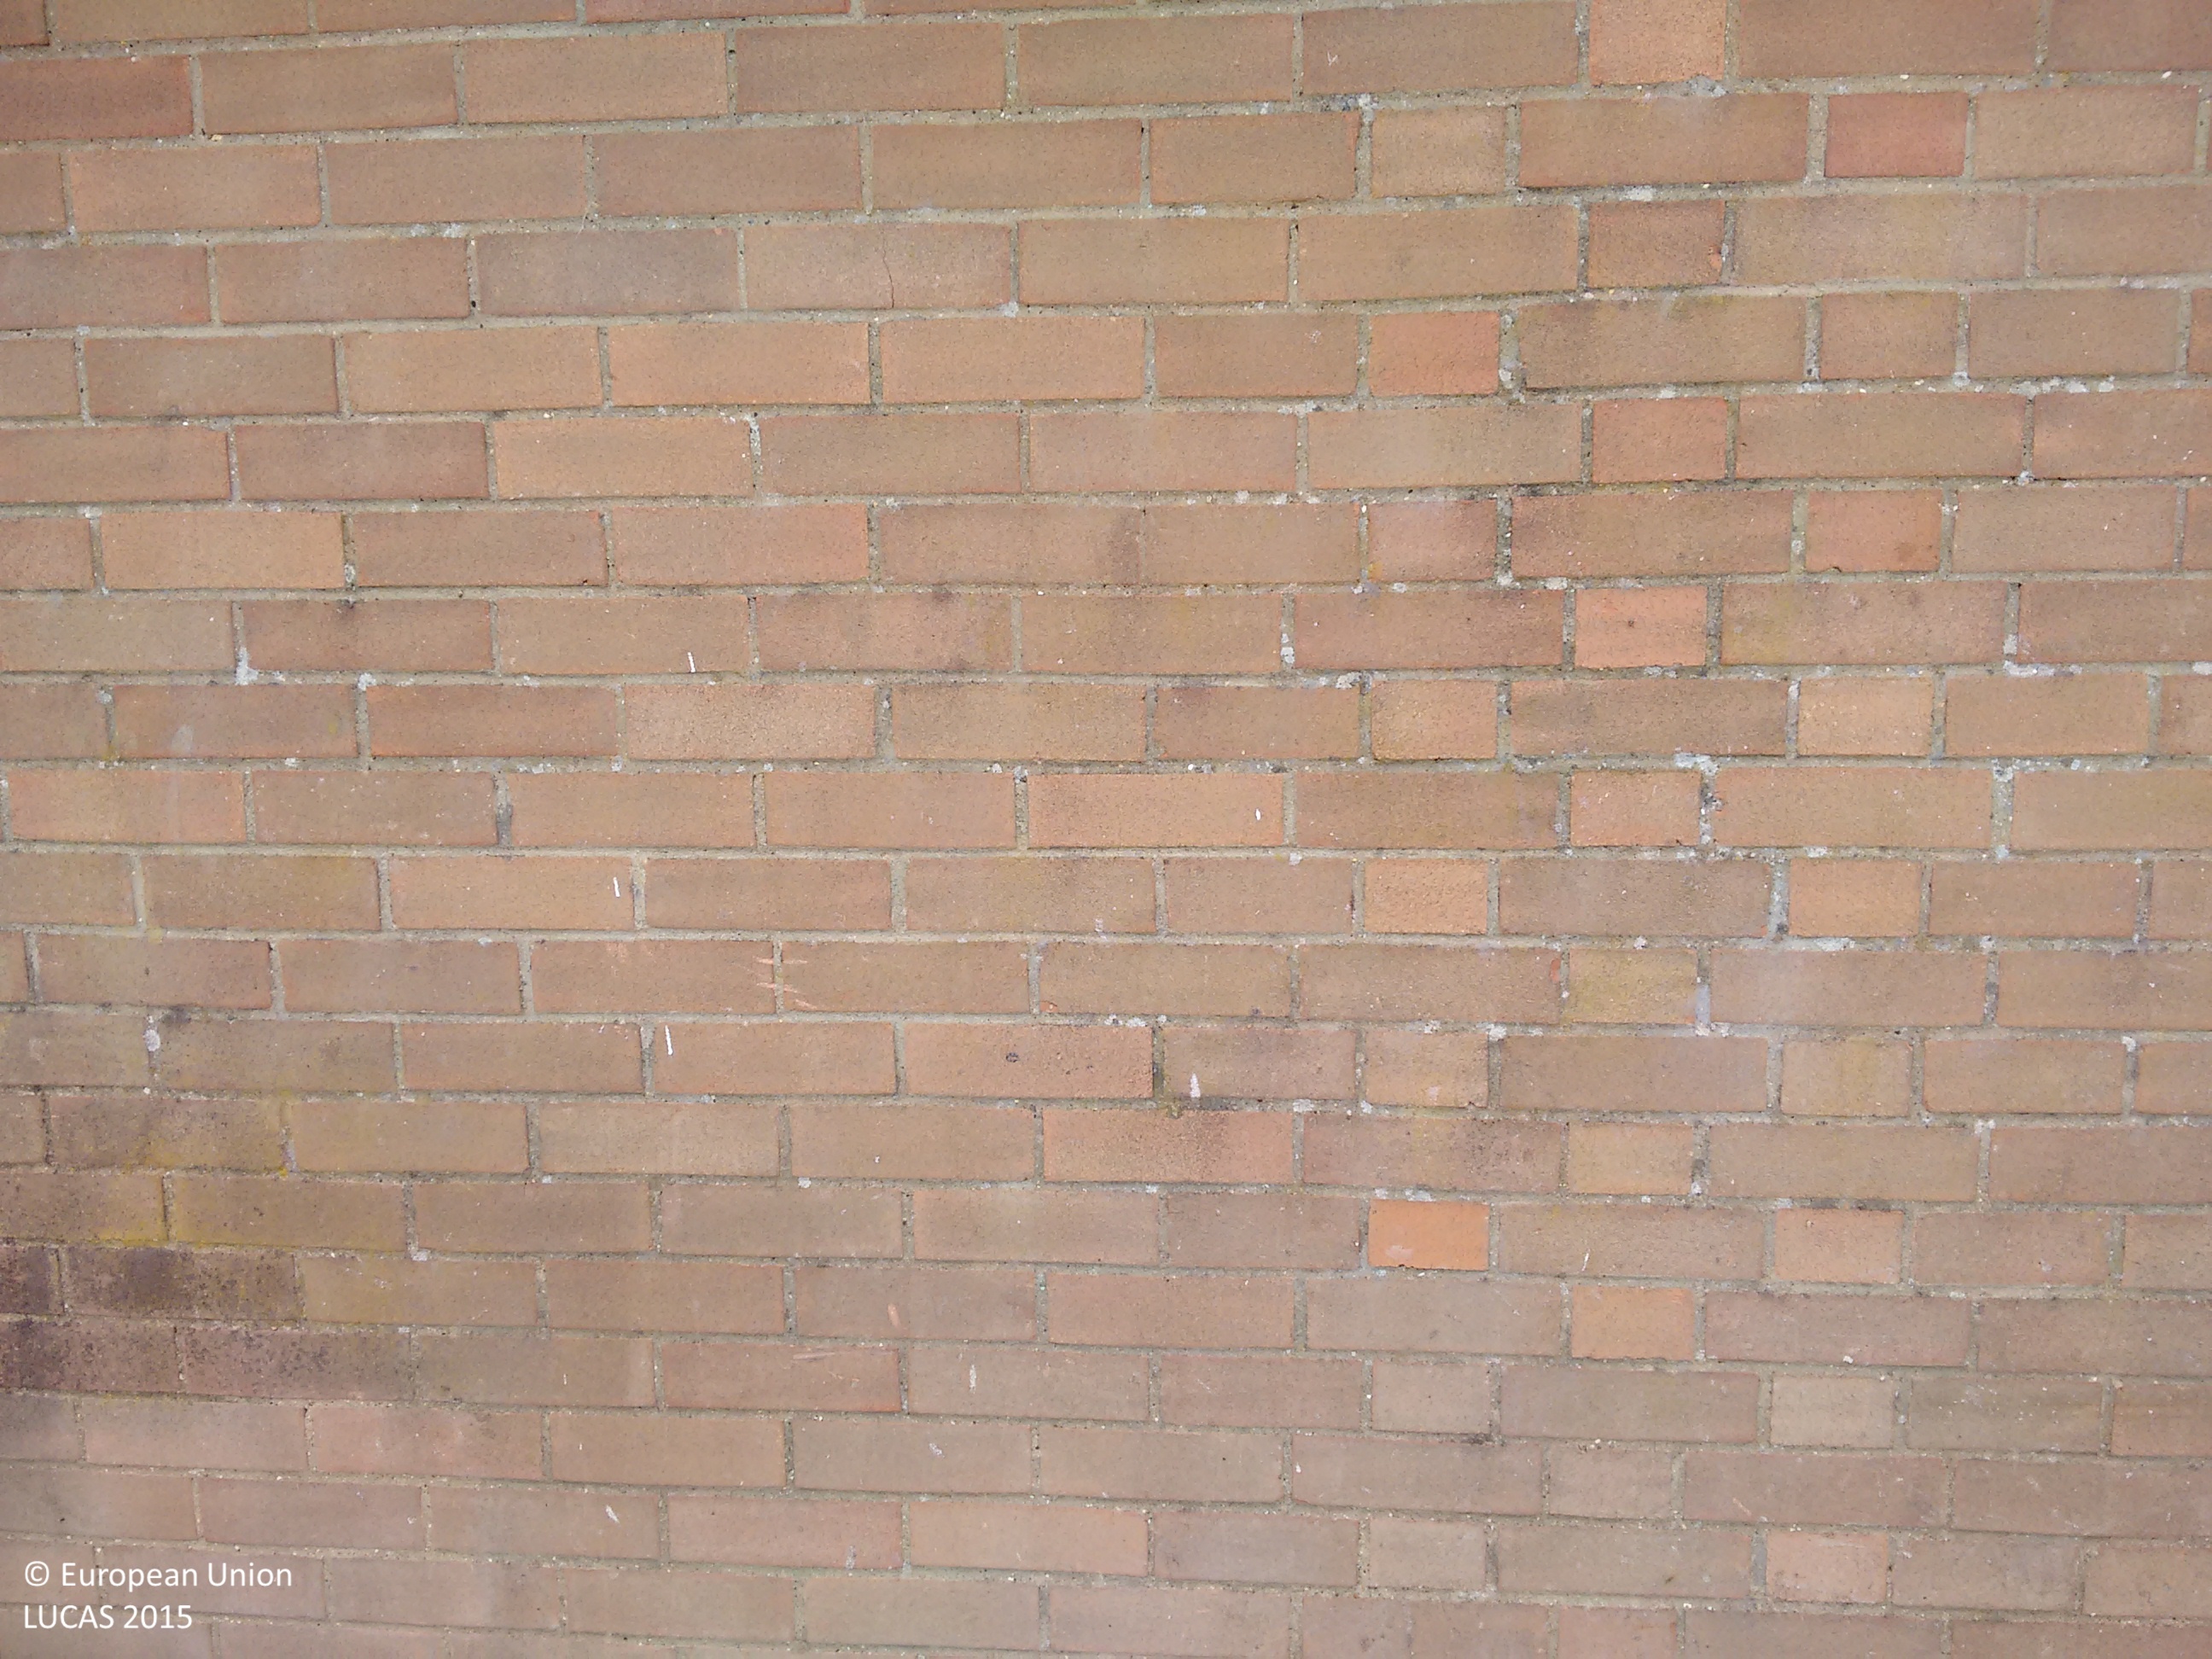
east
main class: Cropland
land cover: Common wheat
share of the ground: > 75 %
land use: Agriculture (excluding fallow land and kitchen gardens)
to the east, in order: Common wheat; Grass margins; Artificial constructions in urban areas
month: August
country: GB
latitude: 52.4755
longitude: 0.3870
